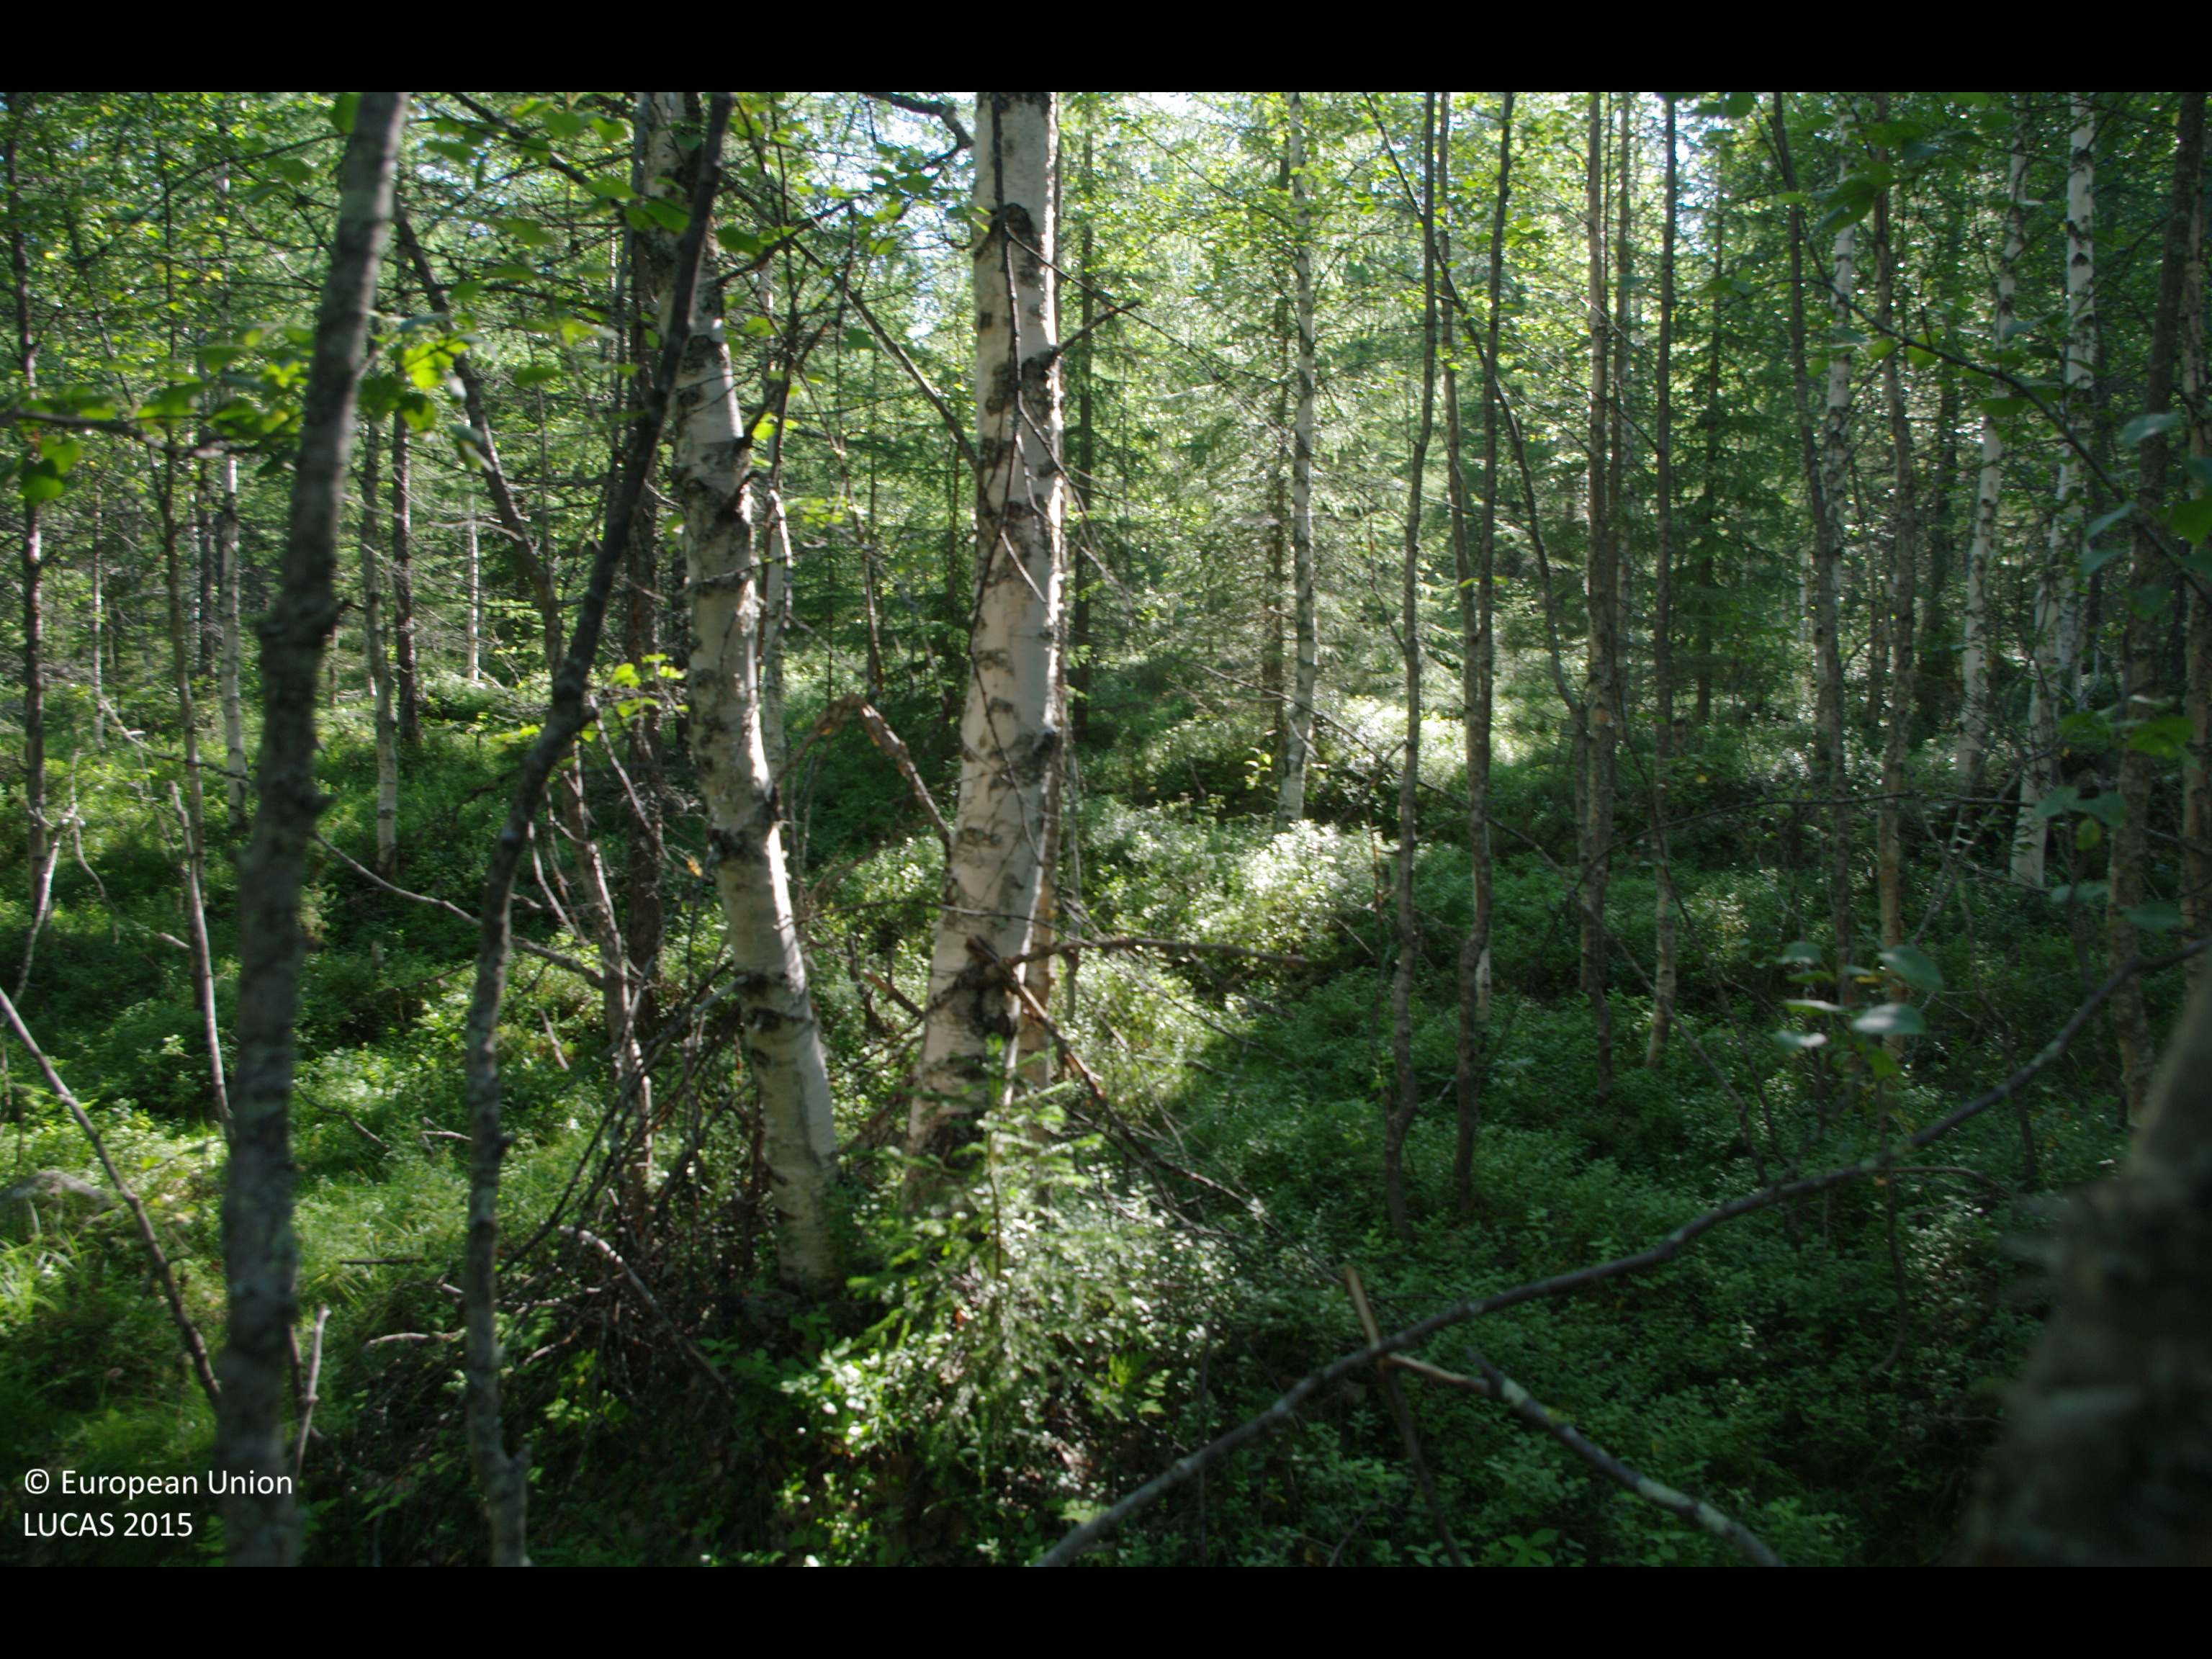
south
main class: Woodland
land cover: Other mixed woodland
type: boreal forest
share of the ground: > 75 %
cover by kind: broadleaved forest trees 50 %, coniferous forest trees 30 %, herbaceous plants 10 %, shrubs 5 %, lichens and mosses 5 %
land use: Forestry
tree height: > 5 m
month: August
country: FI
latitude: 65.6544
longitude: 28.1254
